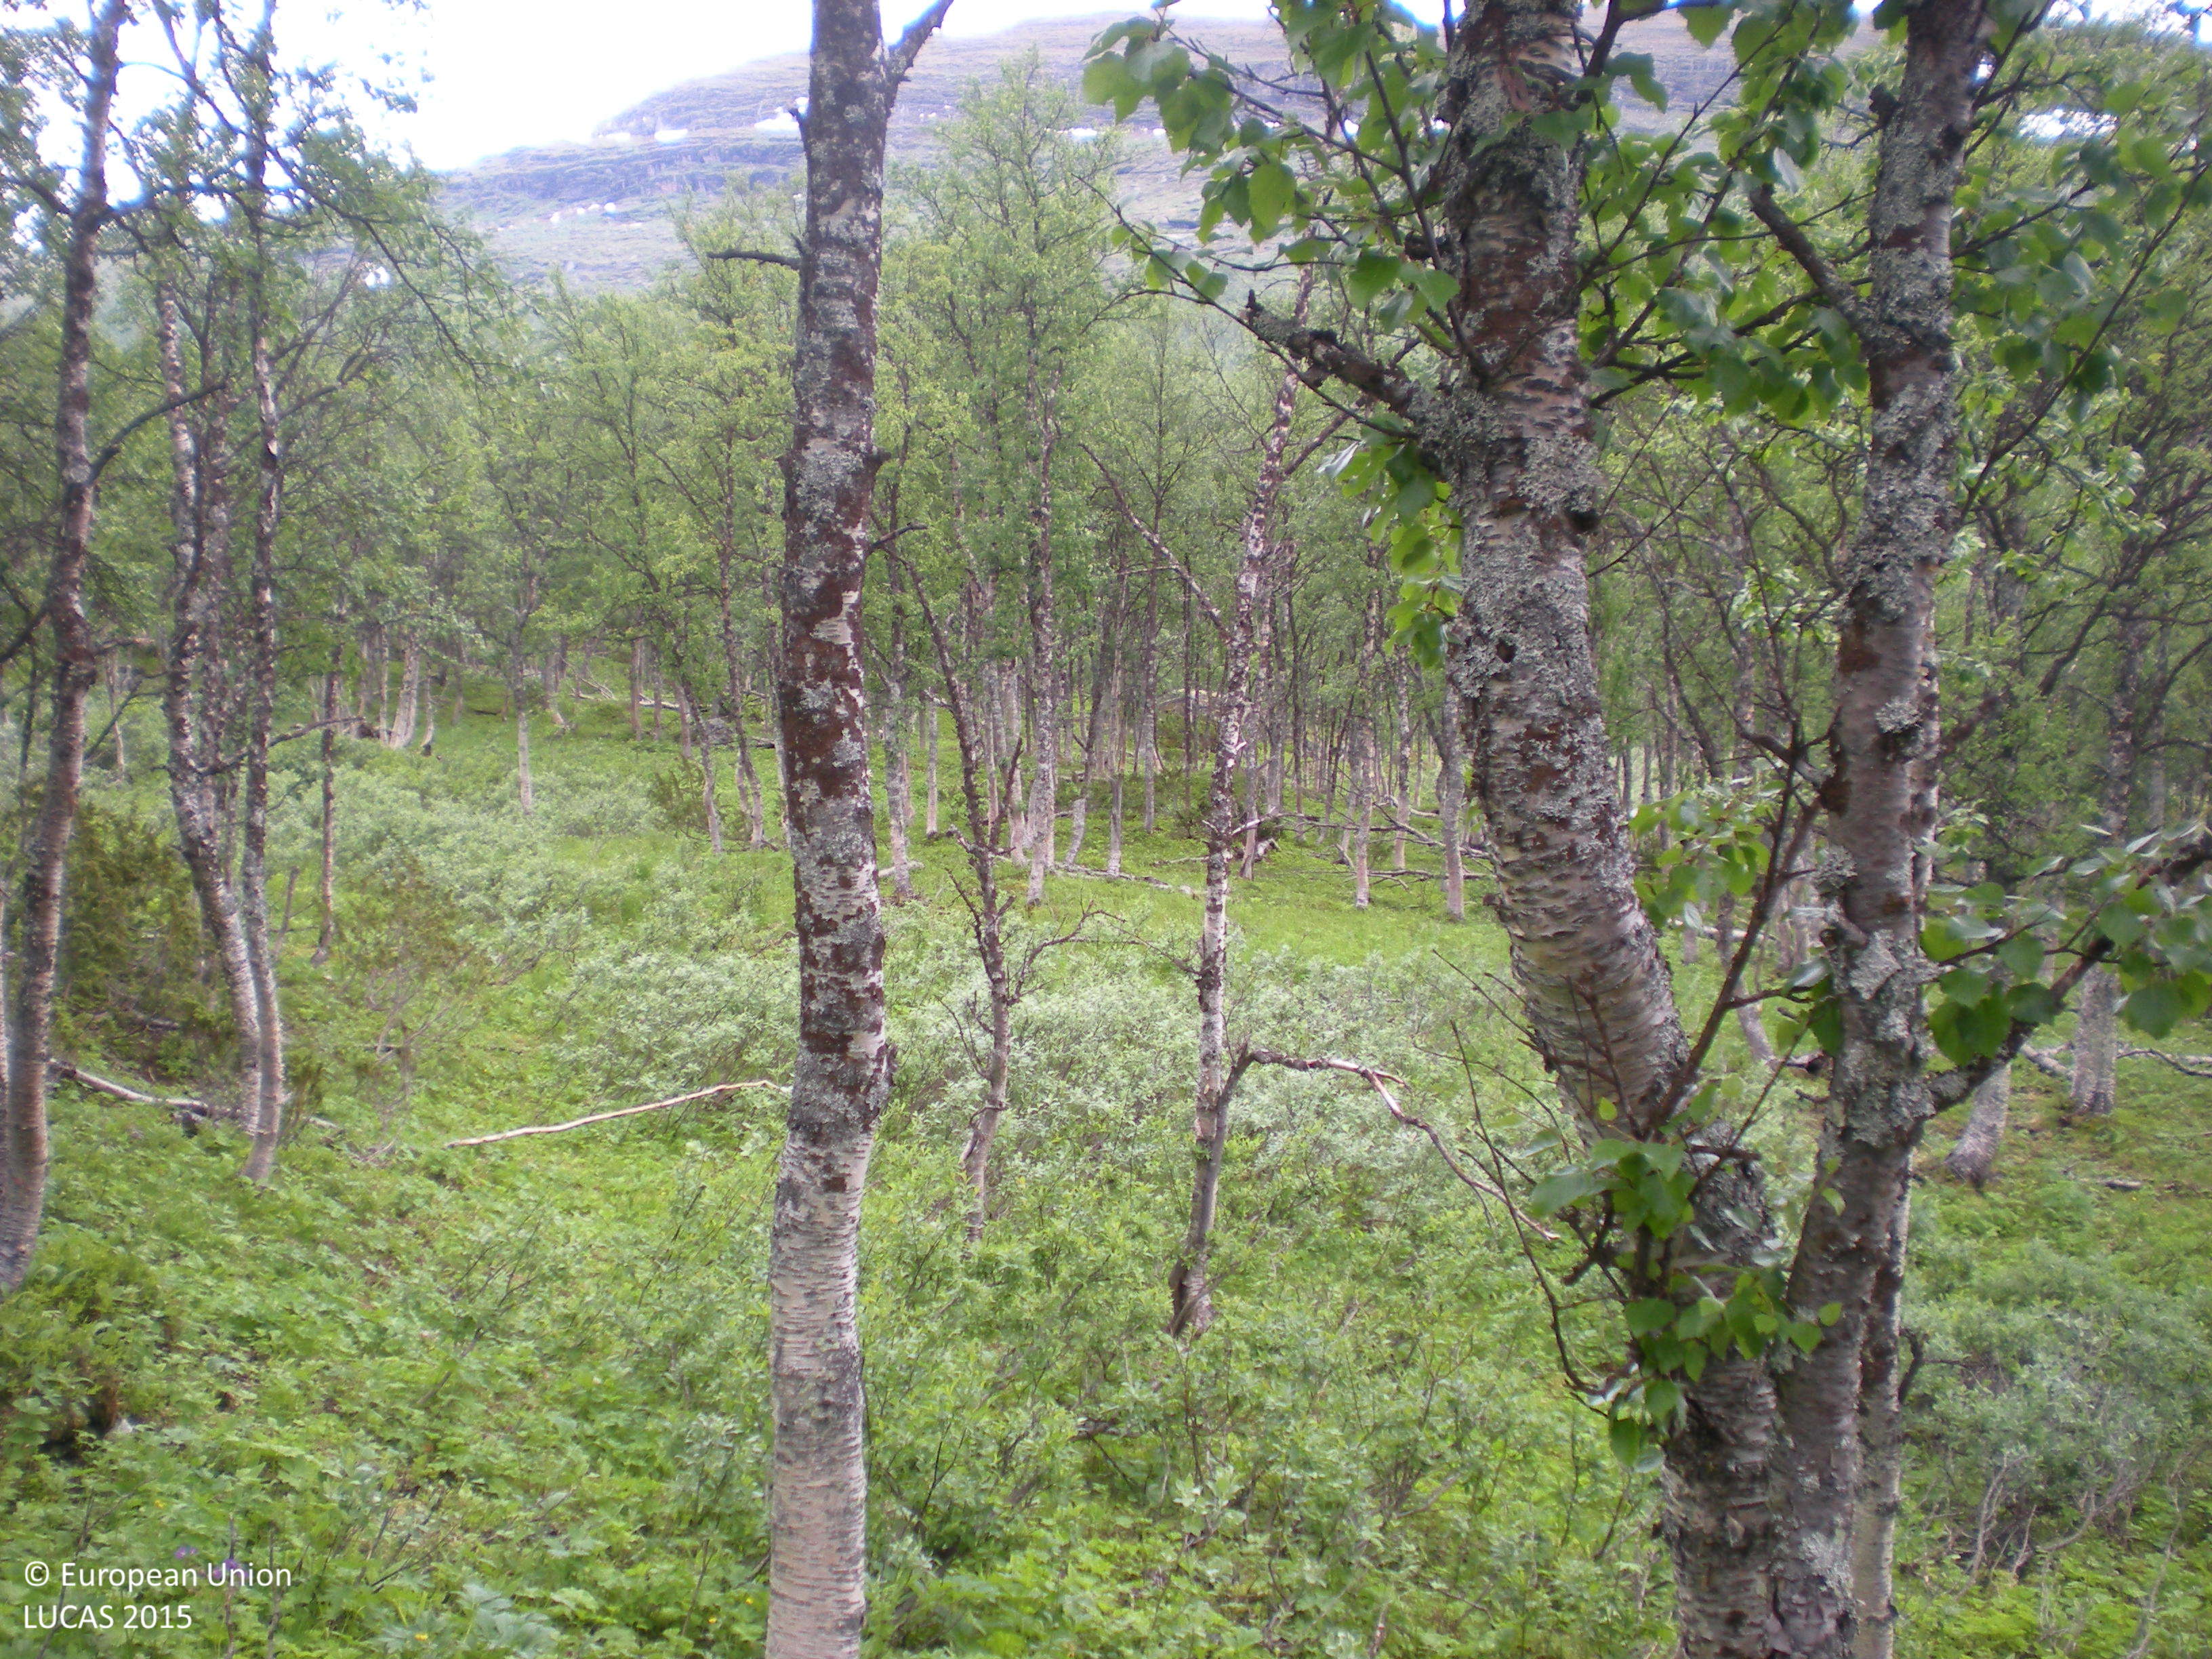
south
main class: Woodland
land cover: Broadleaved woodland
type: boreal forest
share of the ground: 50 - 75 %
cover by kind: broadleaved forest trees 55 %, herbaceous plants 30 %, shrubs 15 %
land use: Semi-natural and natural areas not in use
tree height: > 5 m
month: August
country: SE
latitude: 66.6737
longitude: 16.1332
